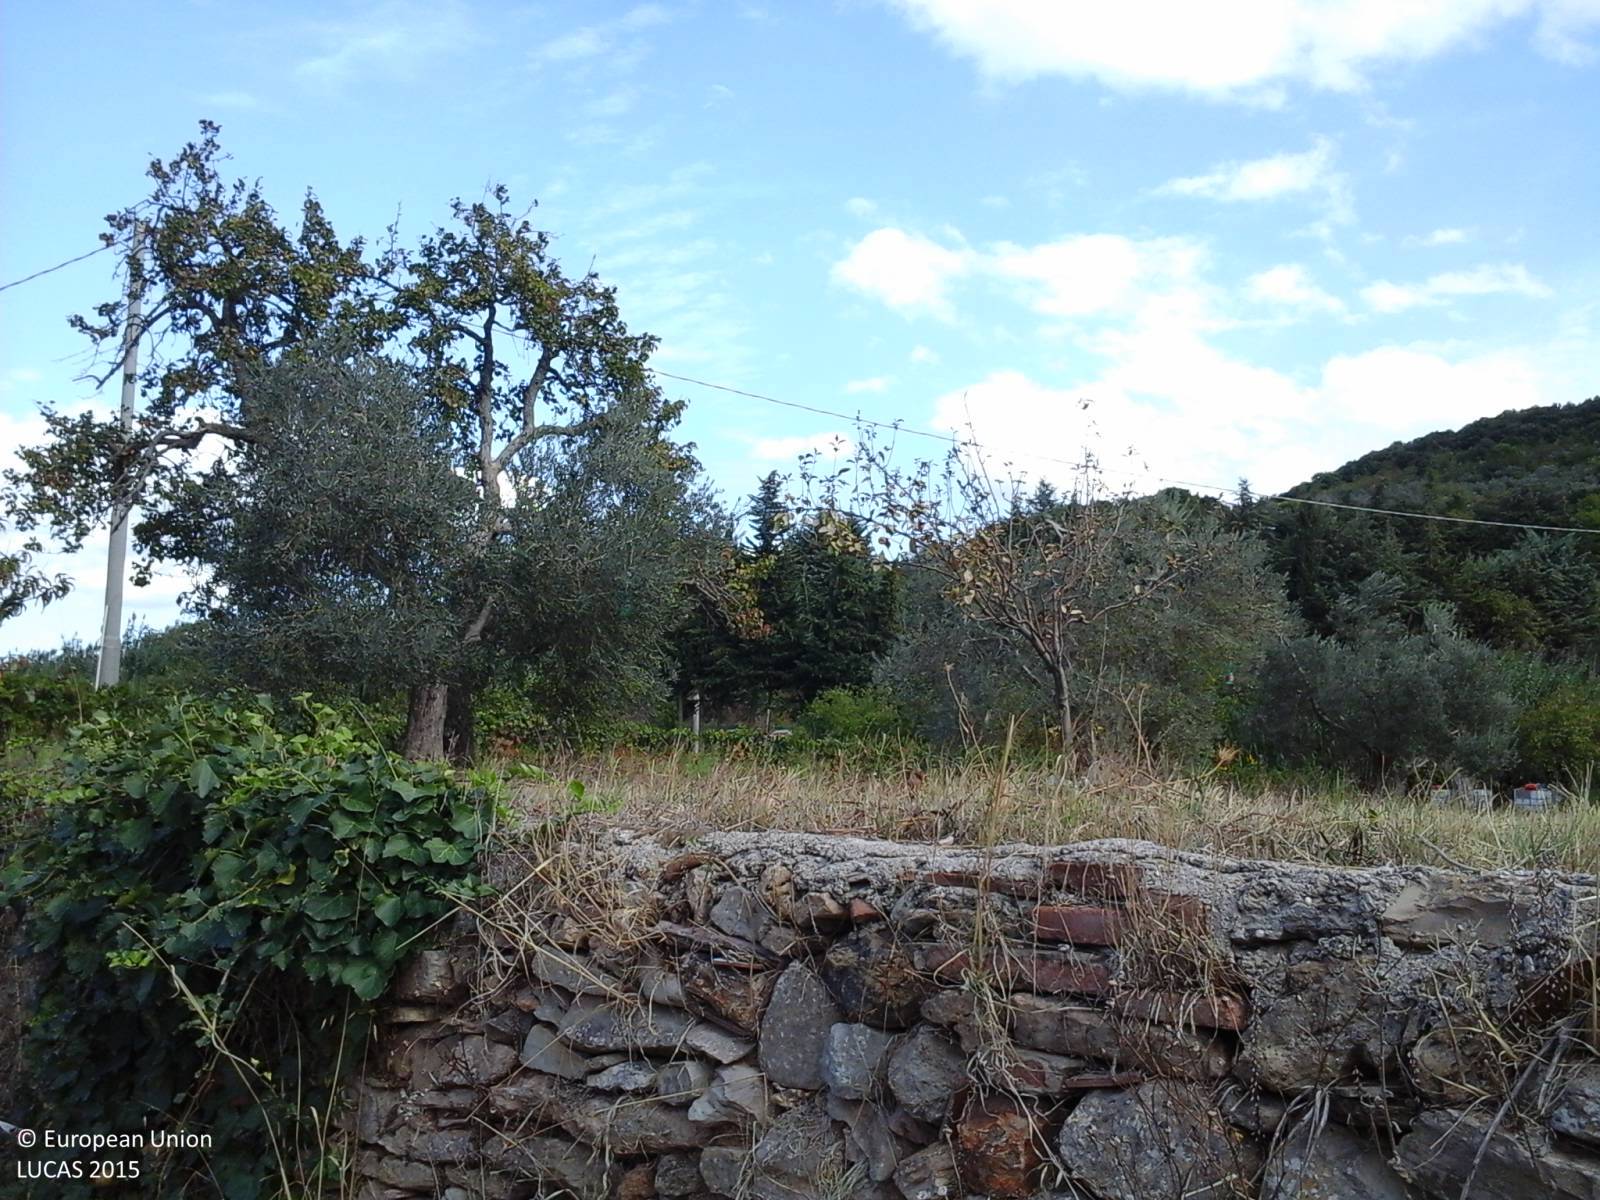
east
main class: Grassland
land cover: Grassland without tree/shrub cover
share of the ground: 50 - 75 %
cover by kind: herbaceous plants 100 %
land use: Agriculture (excluding fallow land and kitchen gardens)
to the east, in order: Grassland without tree/shrub cover; Fences; Paved roads, cycling and walking lanes; Shruby margins; Other cereals; Abandoned hedges; Tracks; Broadleaved woodland; Other fruit trees and berries; Tracks; Electric lines; Grass margins; Fences; Grassland without tree/shrub cover; Managed hedges; Arable land (only in case pi)
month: September
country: IT
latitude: 43.0495
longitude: 10.5997
